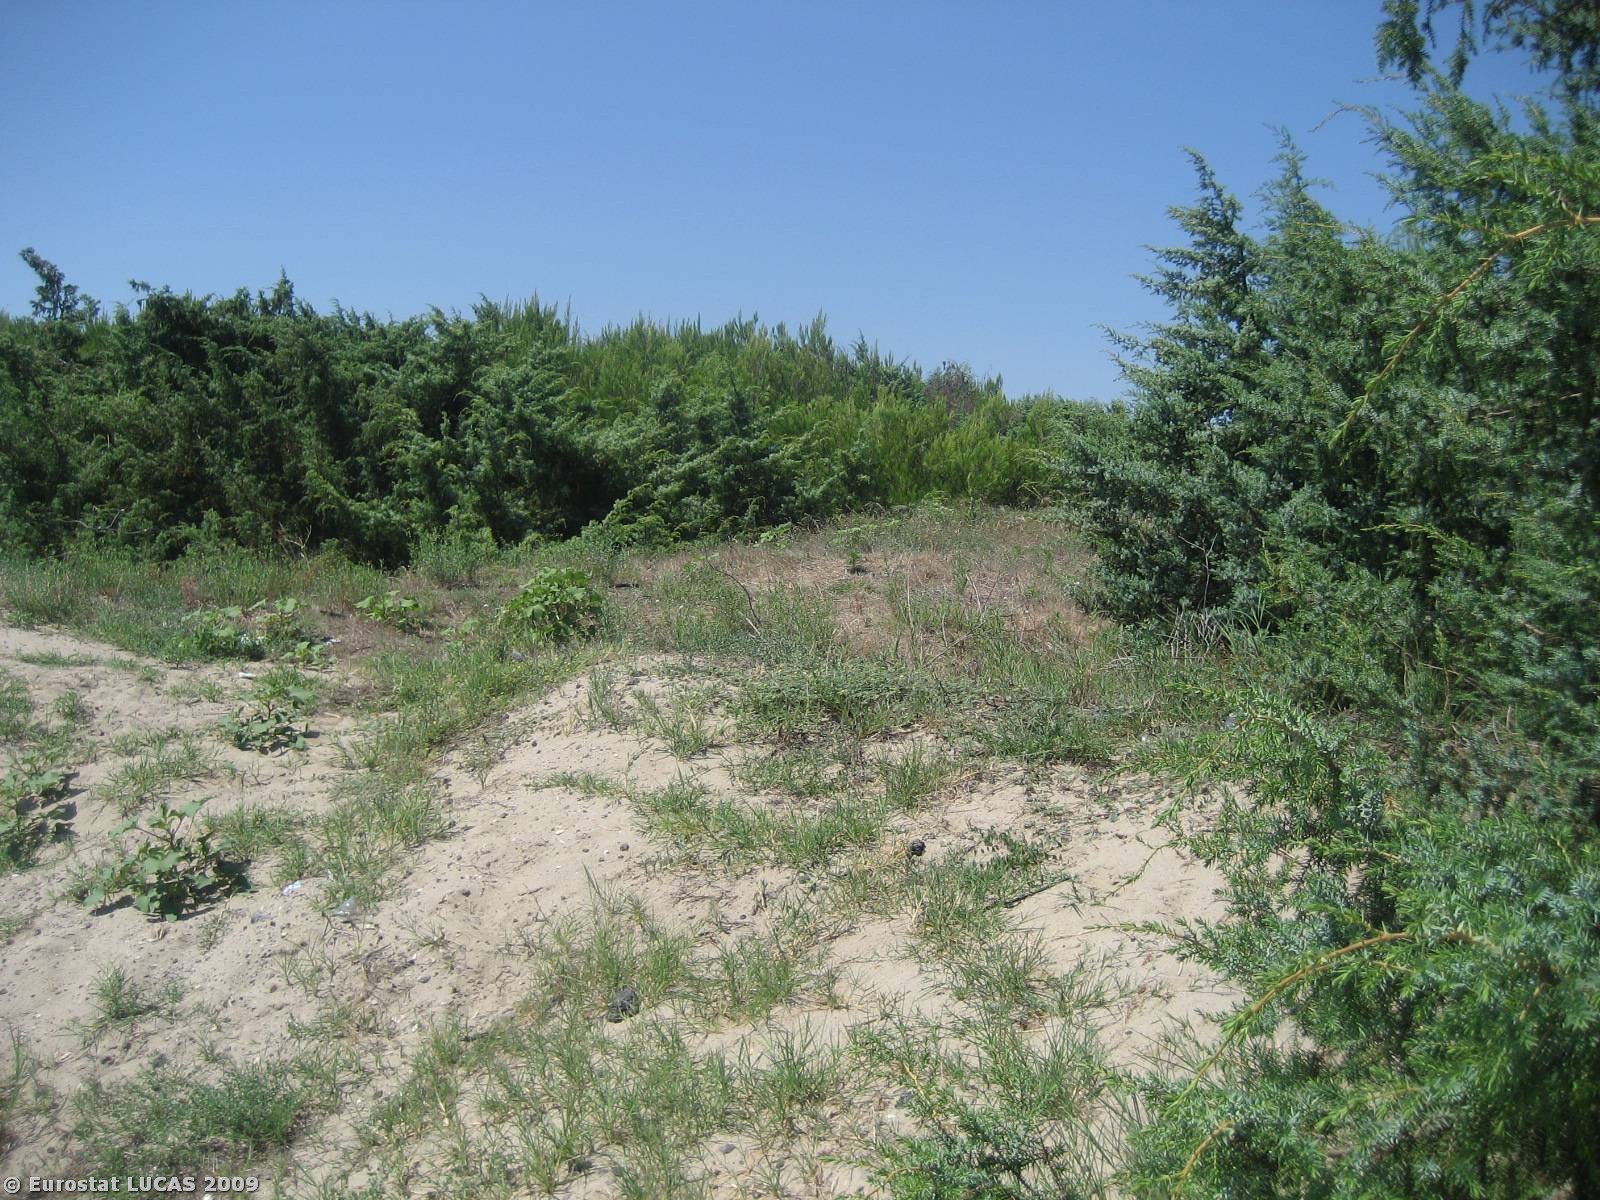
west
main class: Shrubland
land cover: Shrubland without tree cover
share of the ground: > 75 %
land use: Unused
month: July
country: IT
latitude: 41.9166
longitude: 15.3254
